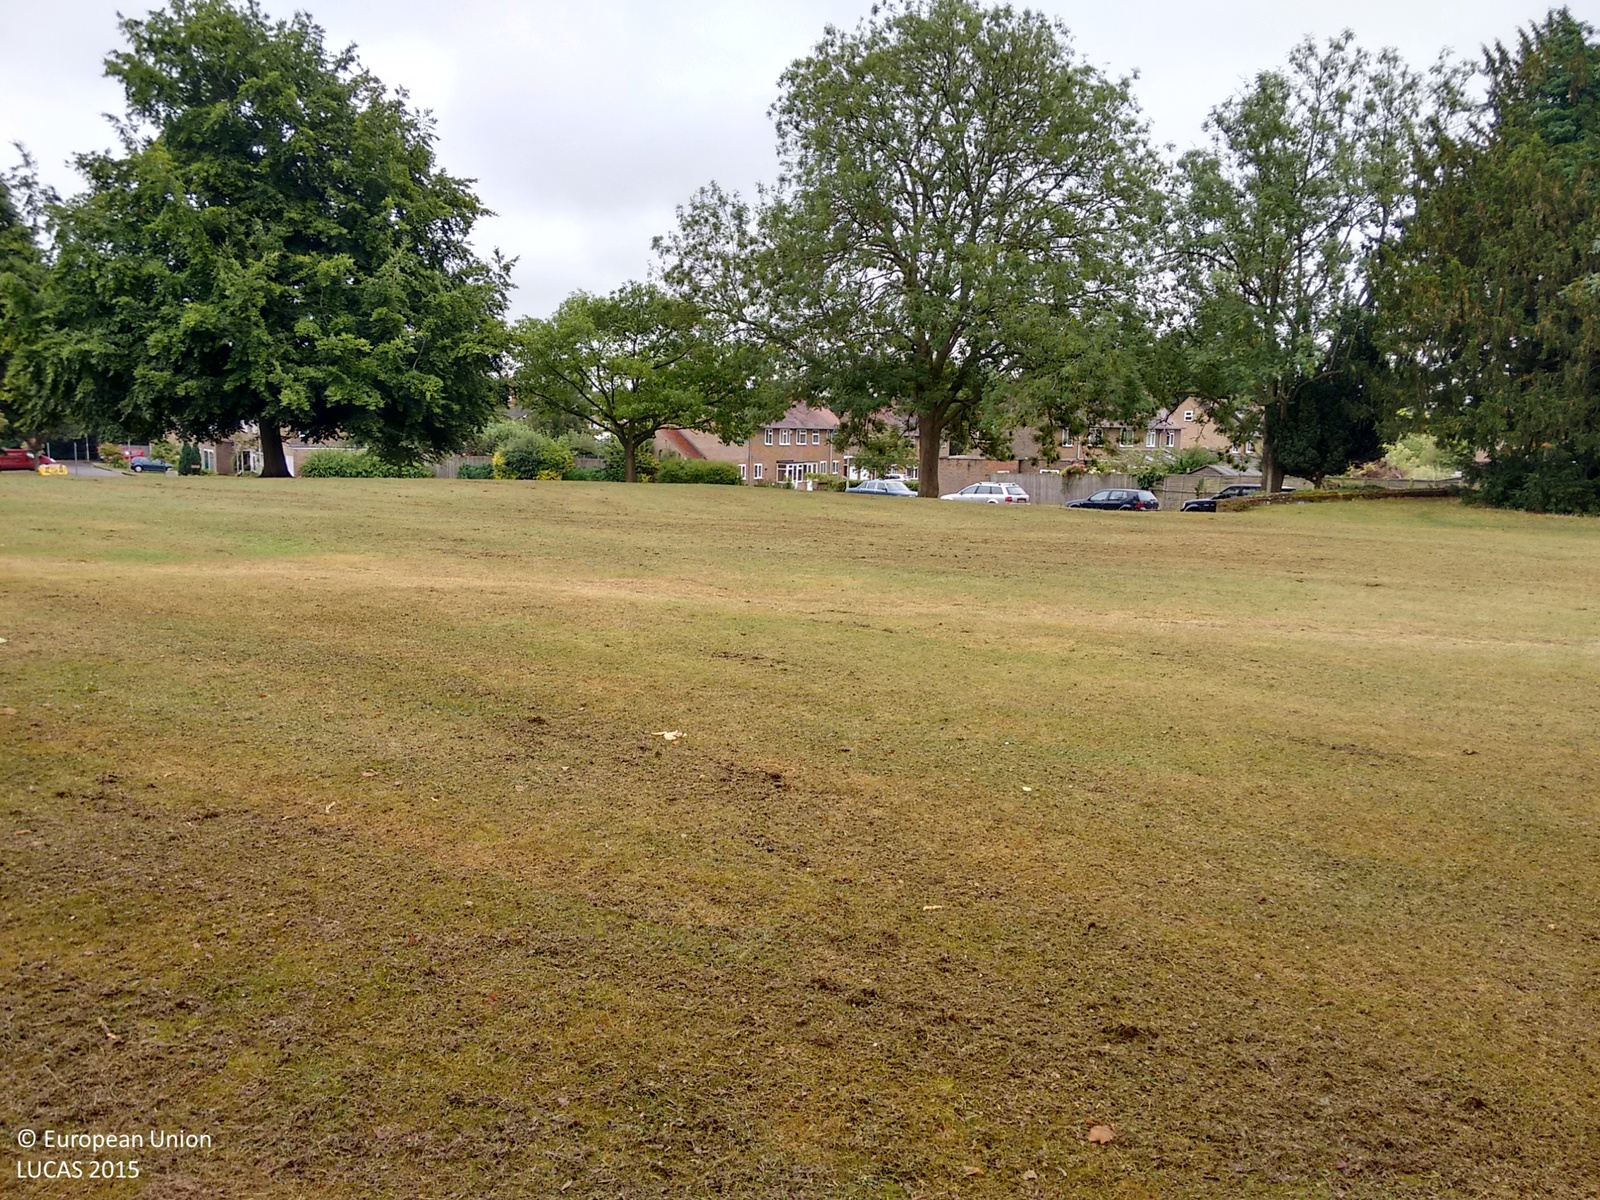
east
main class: Grassland
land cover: Grassland with sparse tree/shrub cover
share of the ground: > 75 %
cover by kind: herbaceous plants 95 %, broadleaved forest trees 5 %
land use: Residential
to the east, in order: Grassland with sparse tree/shrub cover; Artificial constructions in urban areas
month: July
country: GB
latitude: 51.6740
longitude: -1.2842
